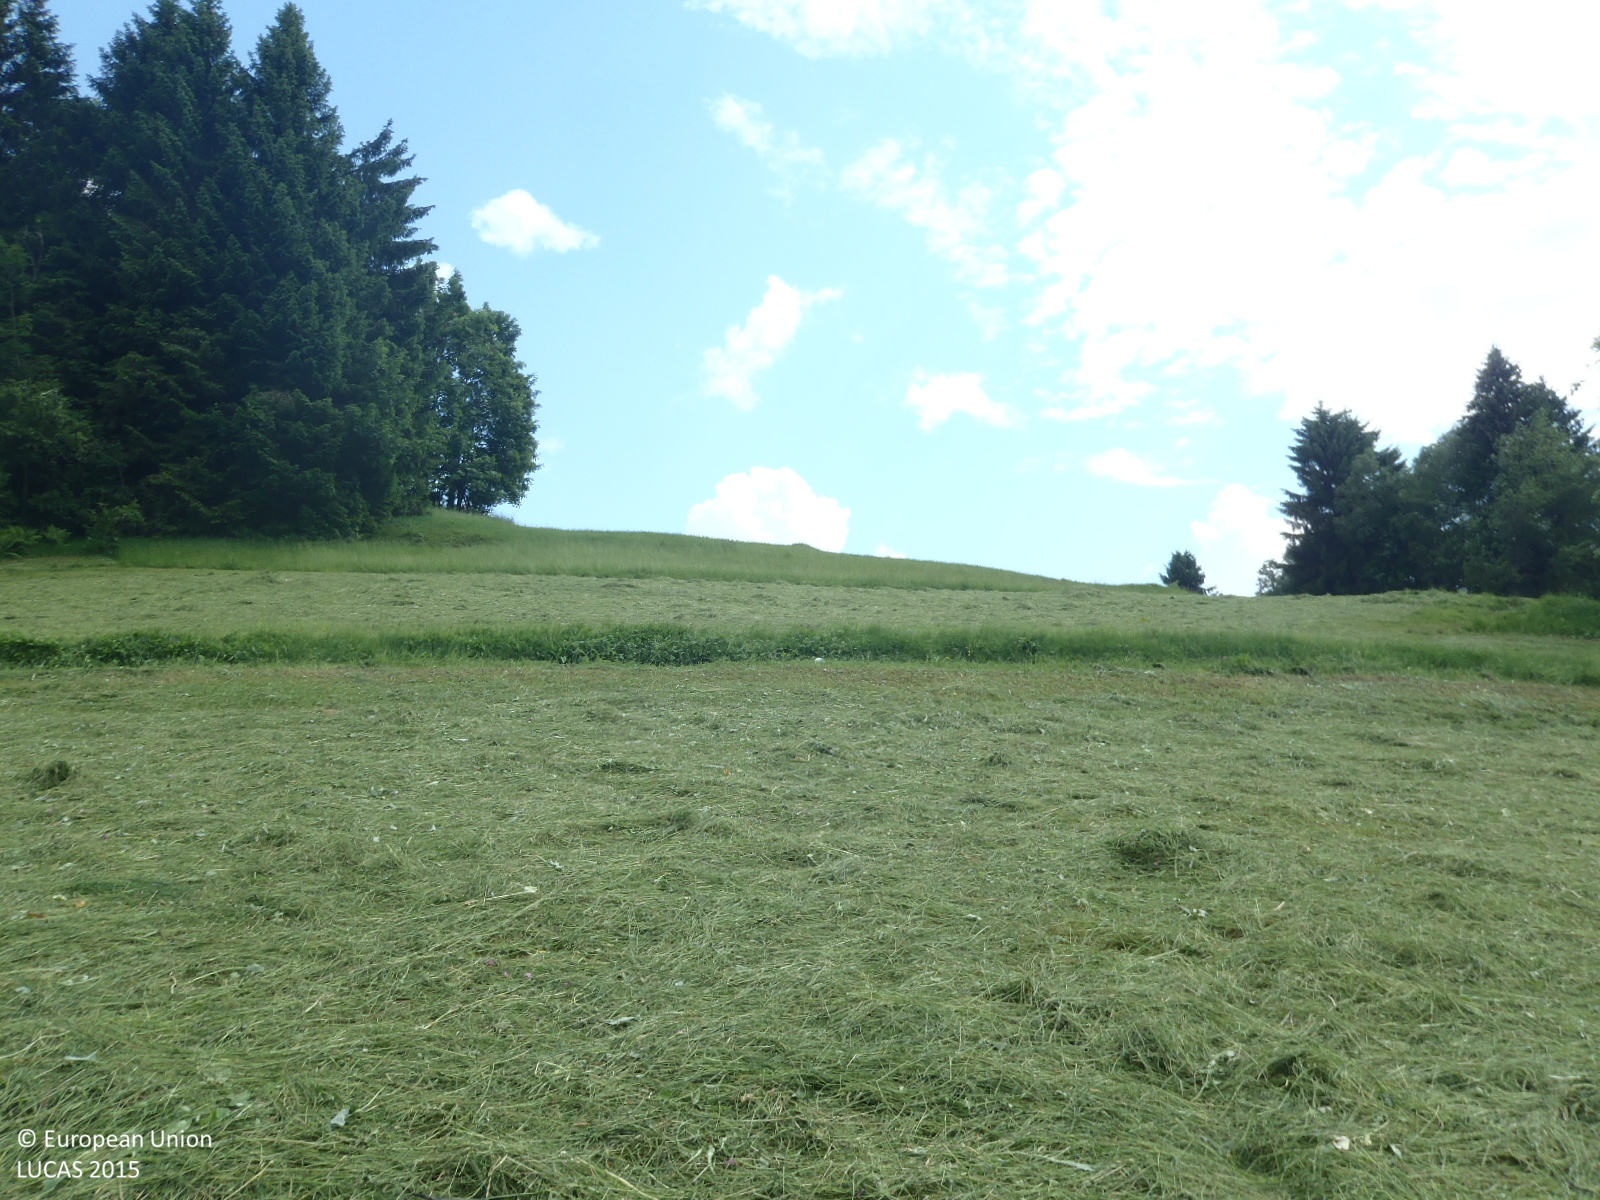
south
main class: Grassland
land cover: Grassland without tree/shrub cover
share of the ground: > 75 %
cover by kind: herbaceous plants 100 %
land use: Agriculture (excluding fallow land and kitchen gardens)
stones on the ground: < 10 %
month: June
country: AT
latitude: 47.5747
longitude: 10.4383
